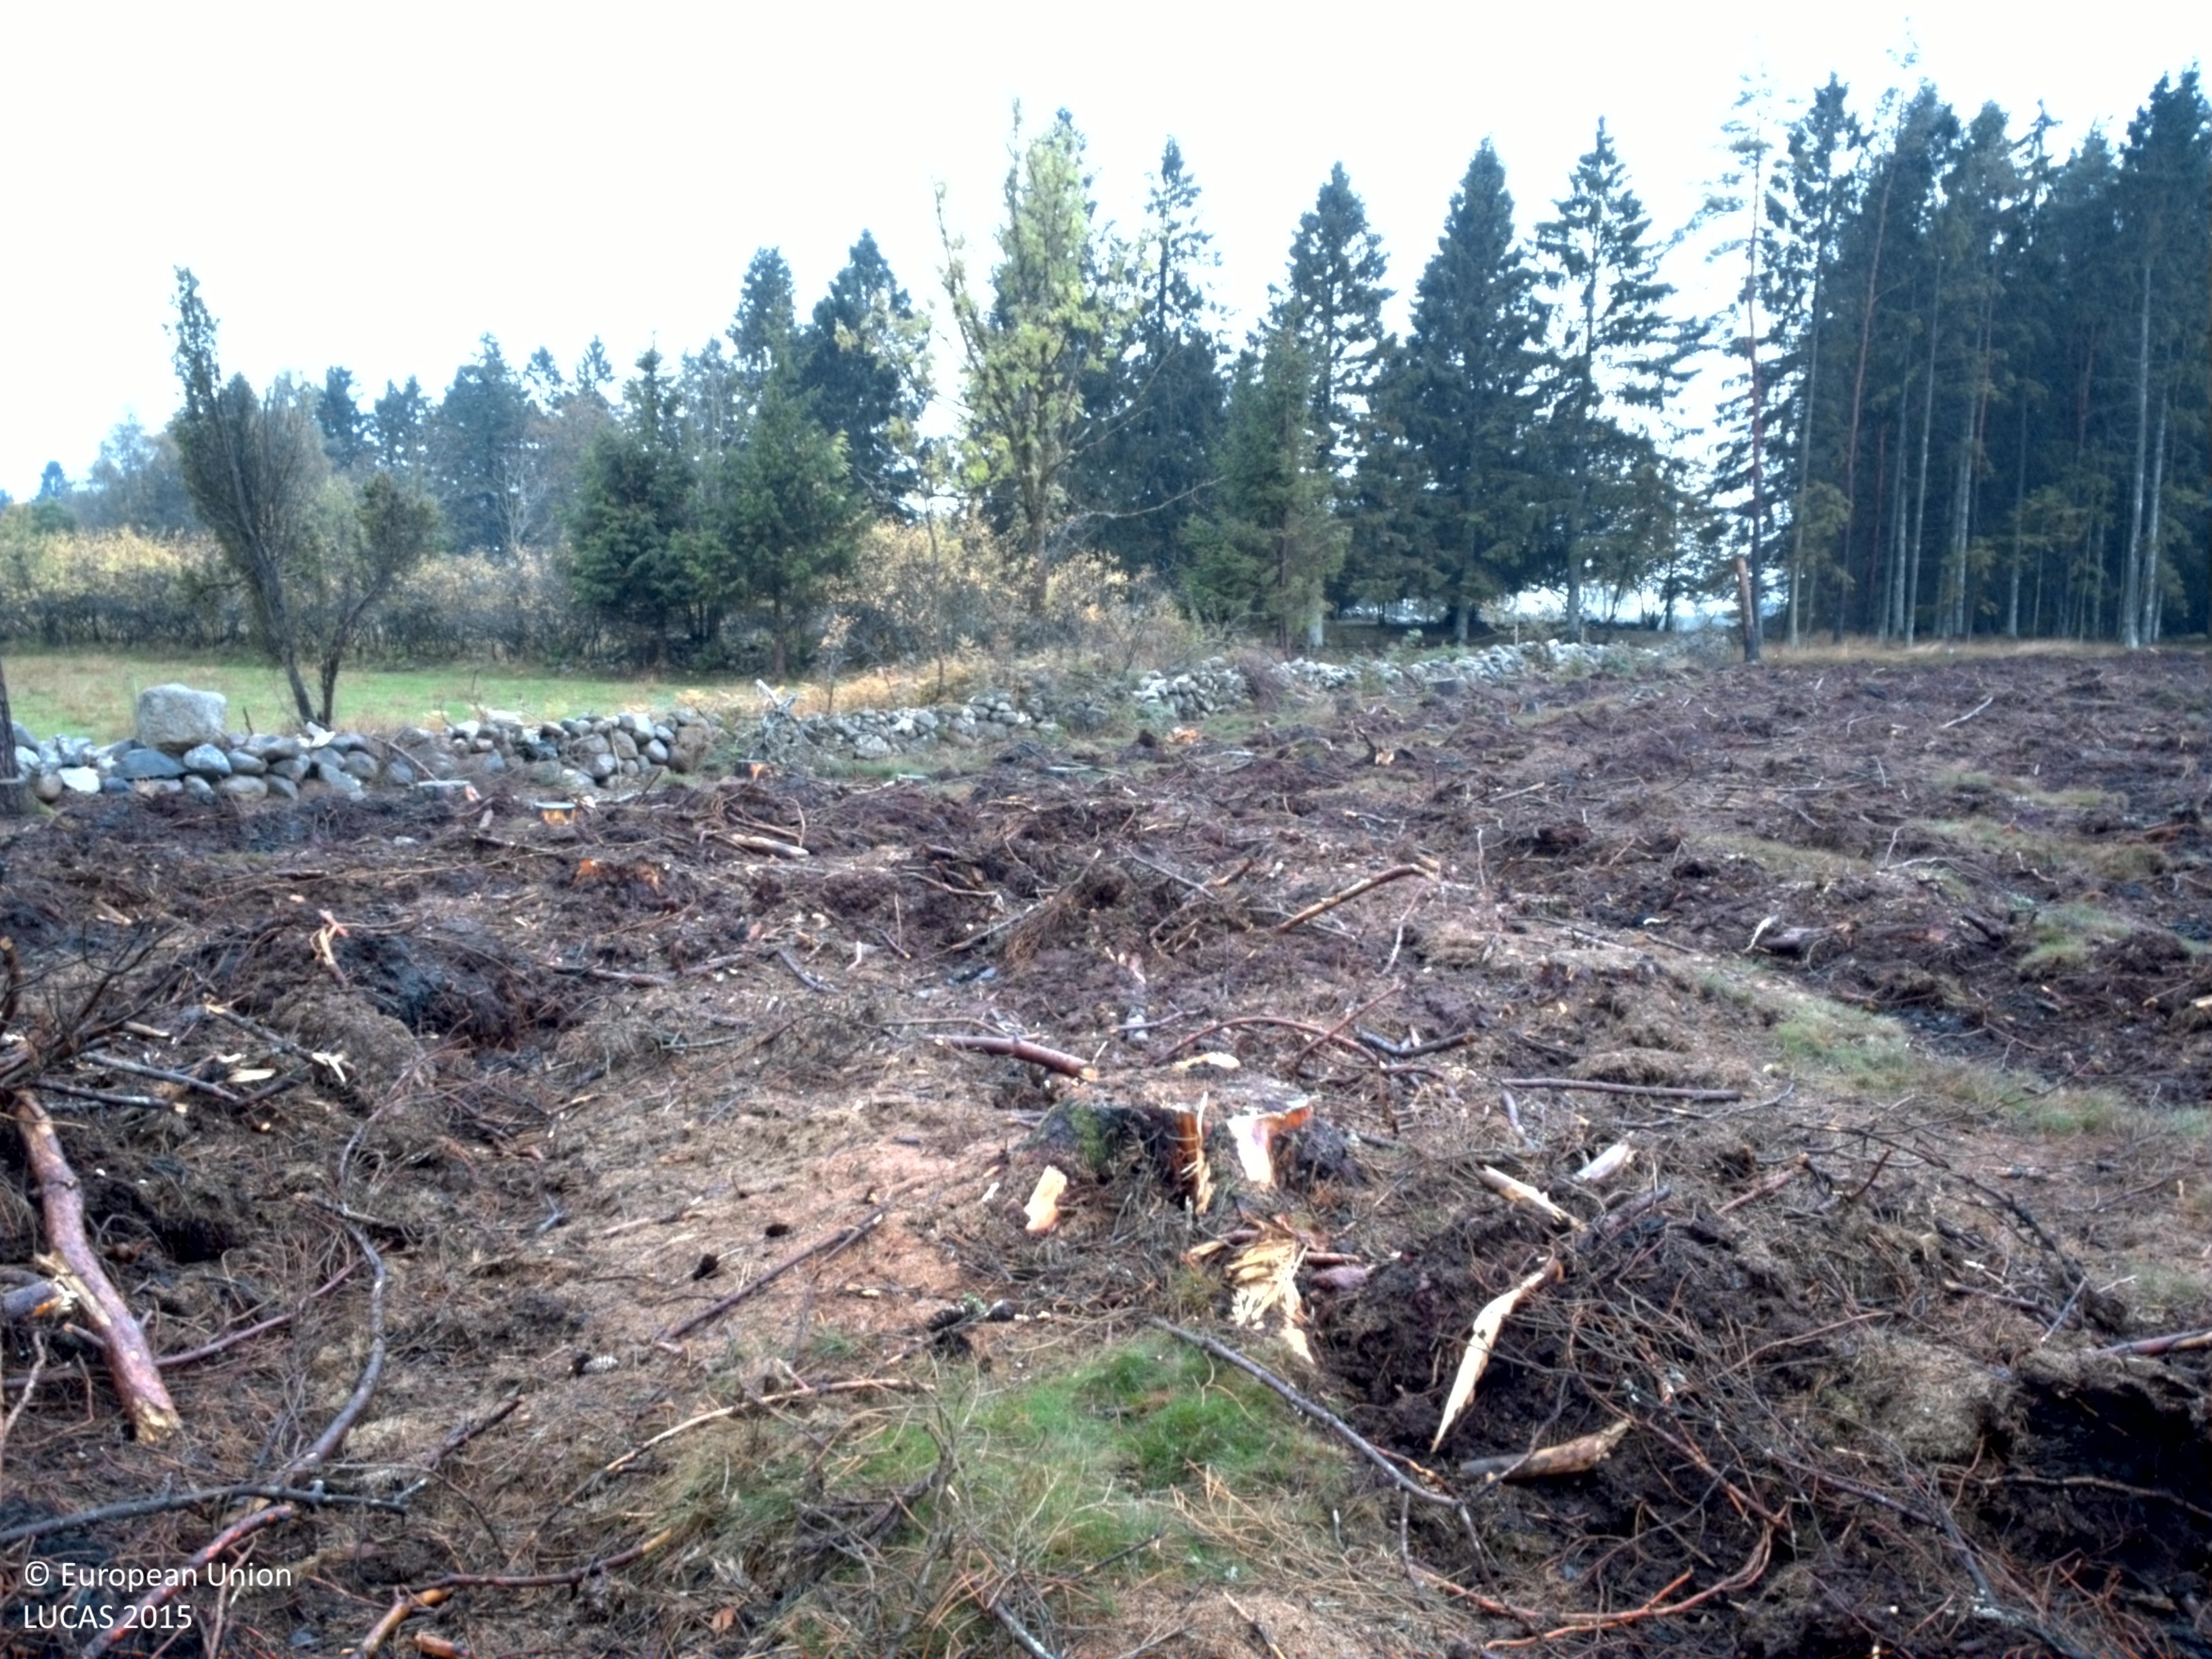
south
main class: Grassland
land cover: Grassland without tree/shrub cover
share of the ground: 10 - 25 %
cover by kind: unconsolidated bare surface 40 %, herbaceous plants 15 %
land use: Forestry
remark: Clear cut
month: October
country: SE
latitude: 55.7296
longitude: 13.9951
